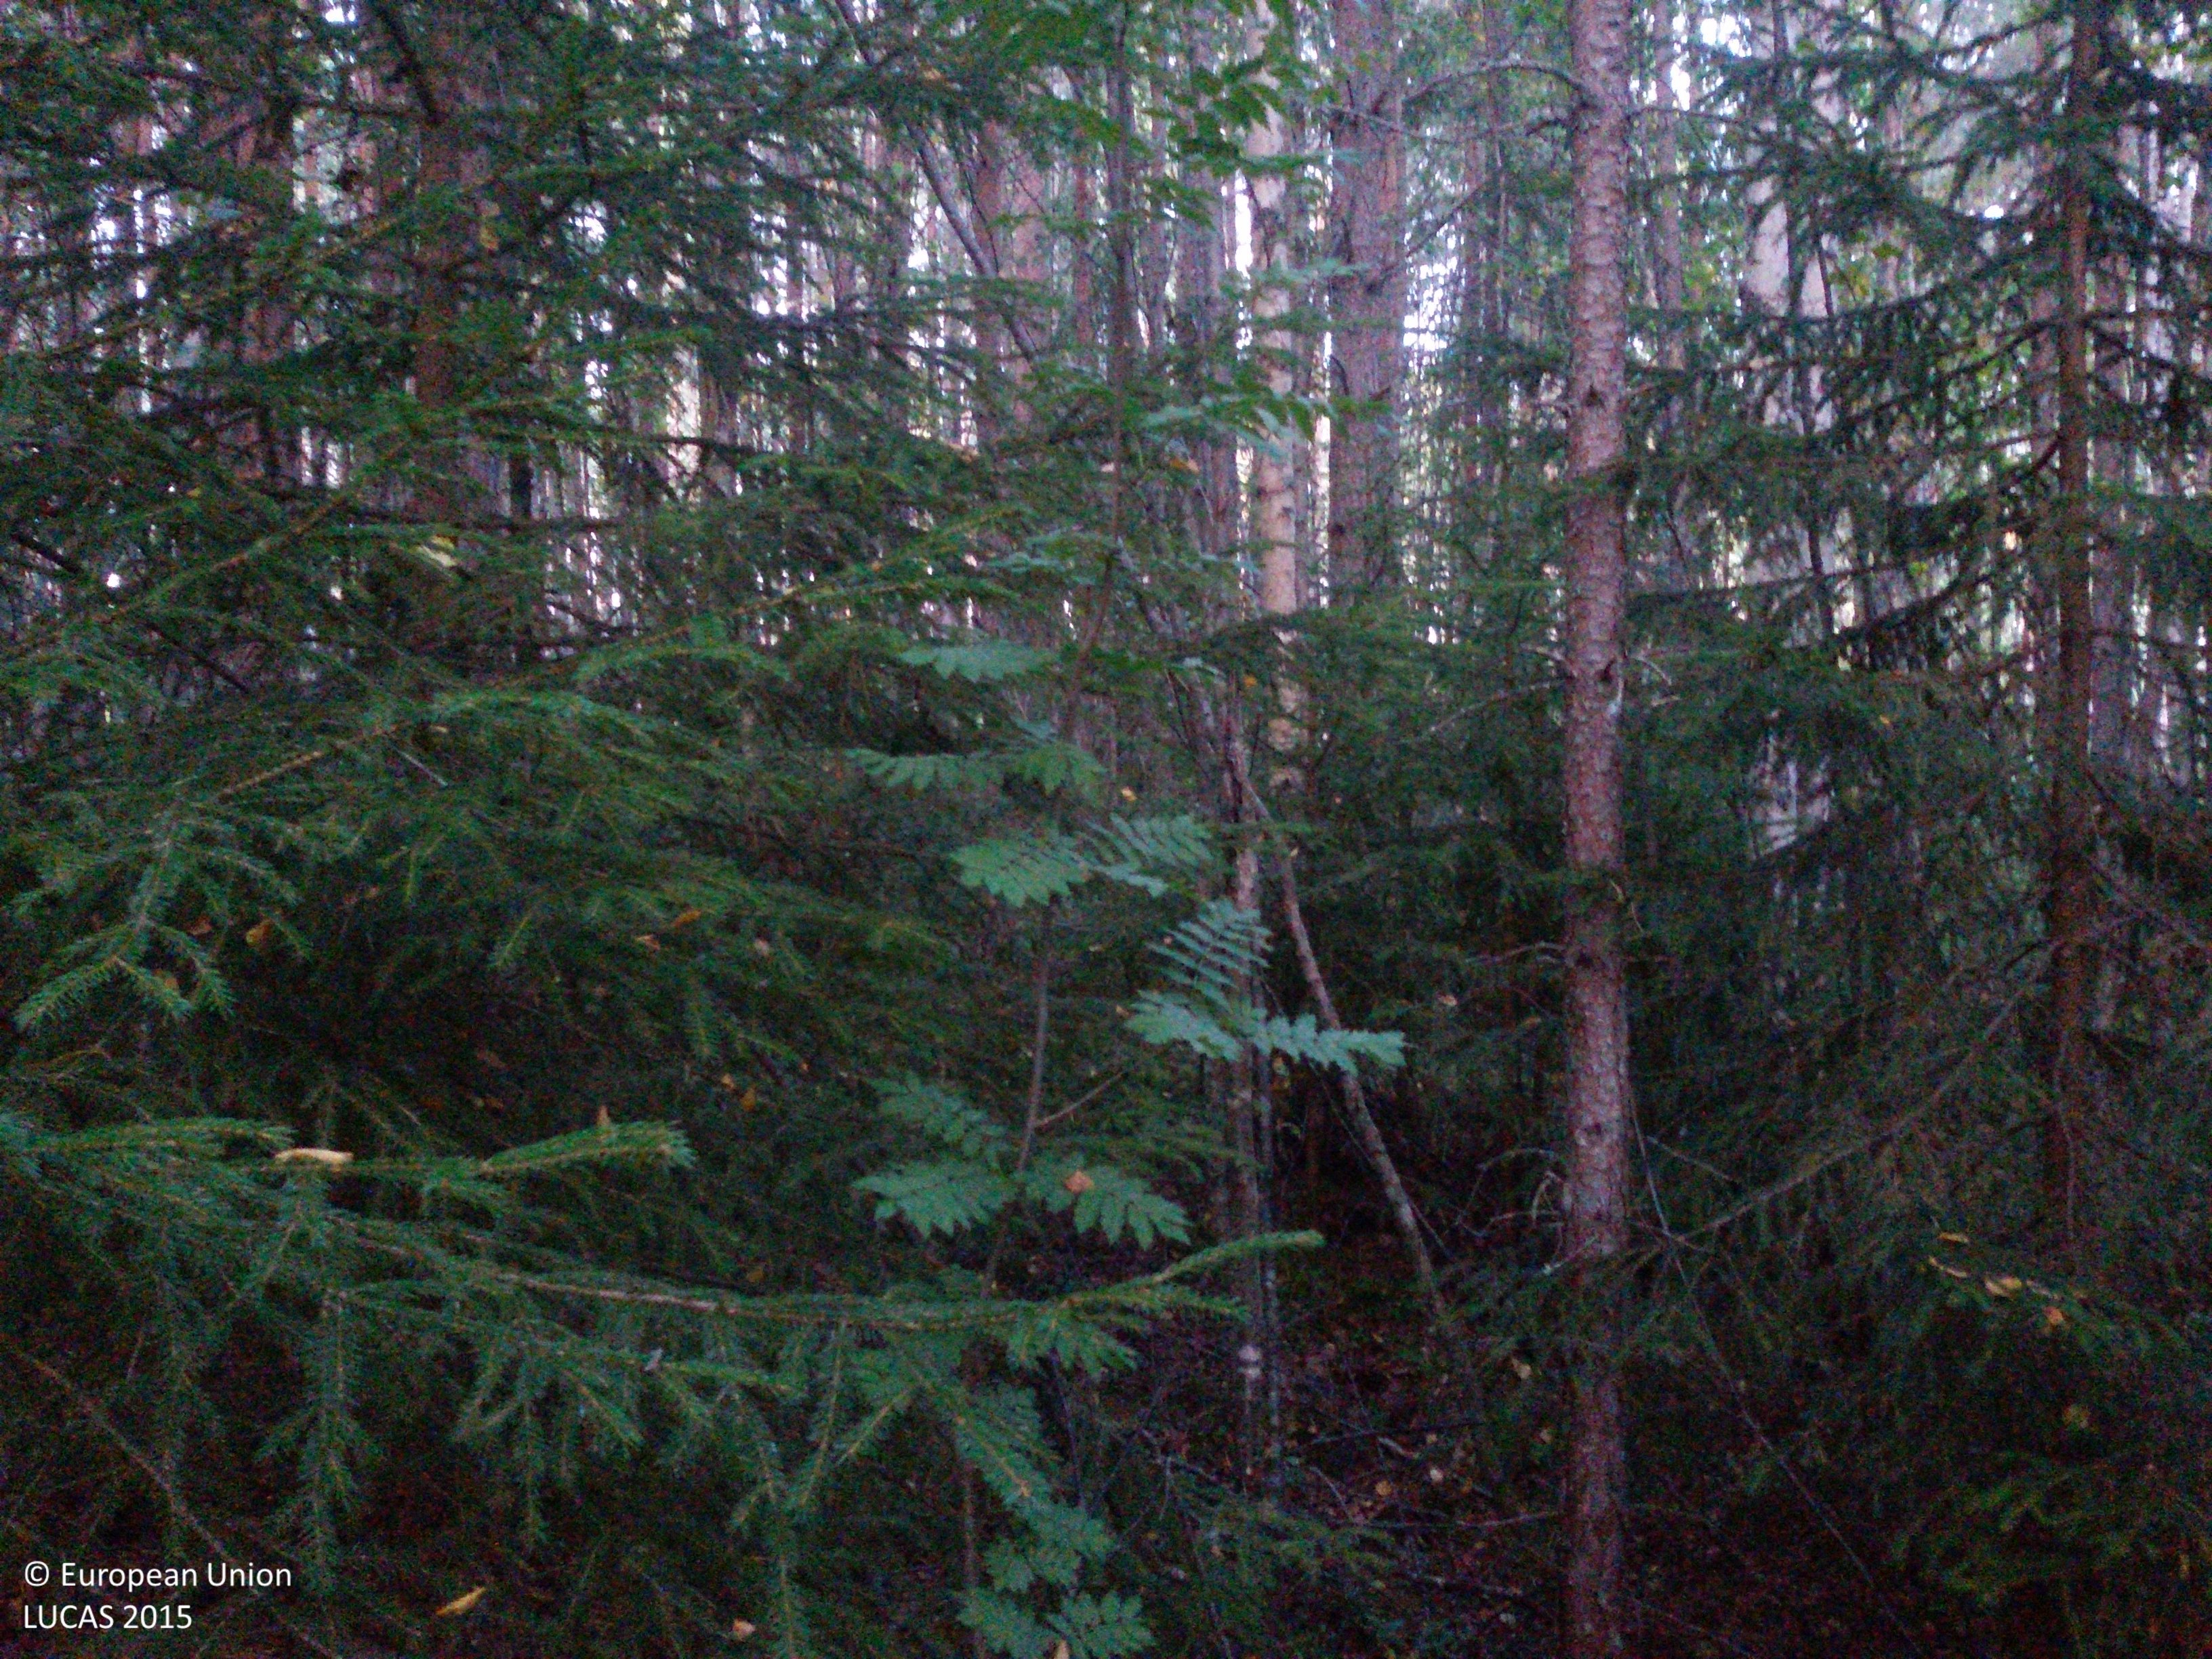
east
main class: Woodland
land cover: Pine dominated mixed woodland
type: boreal forest
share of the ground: > 75 %
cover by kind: coniferous forest trees 40 %, broadleaved forest trees 40 %, herbaceous plants 15 %, lichens and mosses 5 %
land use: Forestry
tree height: > 5 m
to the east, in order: Pine dominated mixed woodland; Pine dominated coniferous woodland; Tracks; Pine dominated coniferous woodland
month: September
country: SE
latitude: 60.8880
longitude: 14.9432
